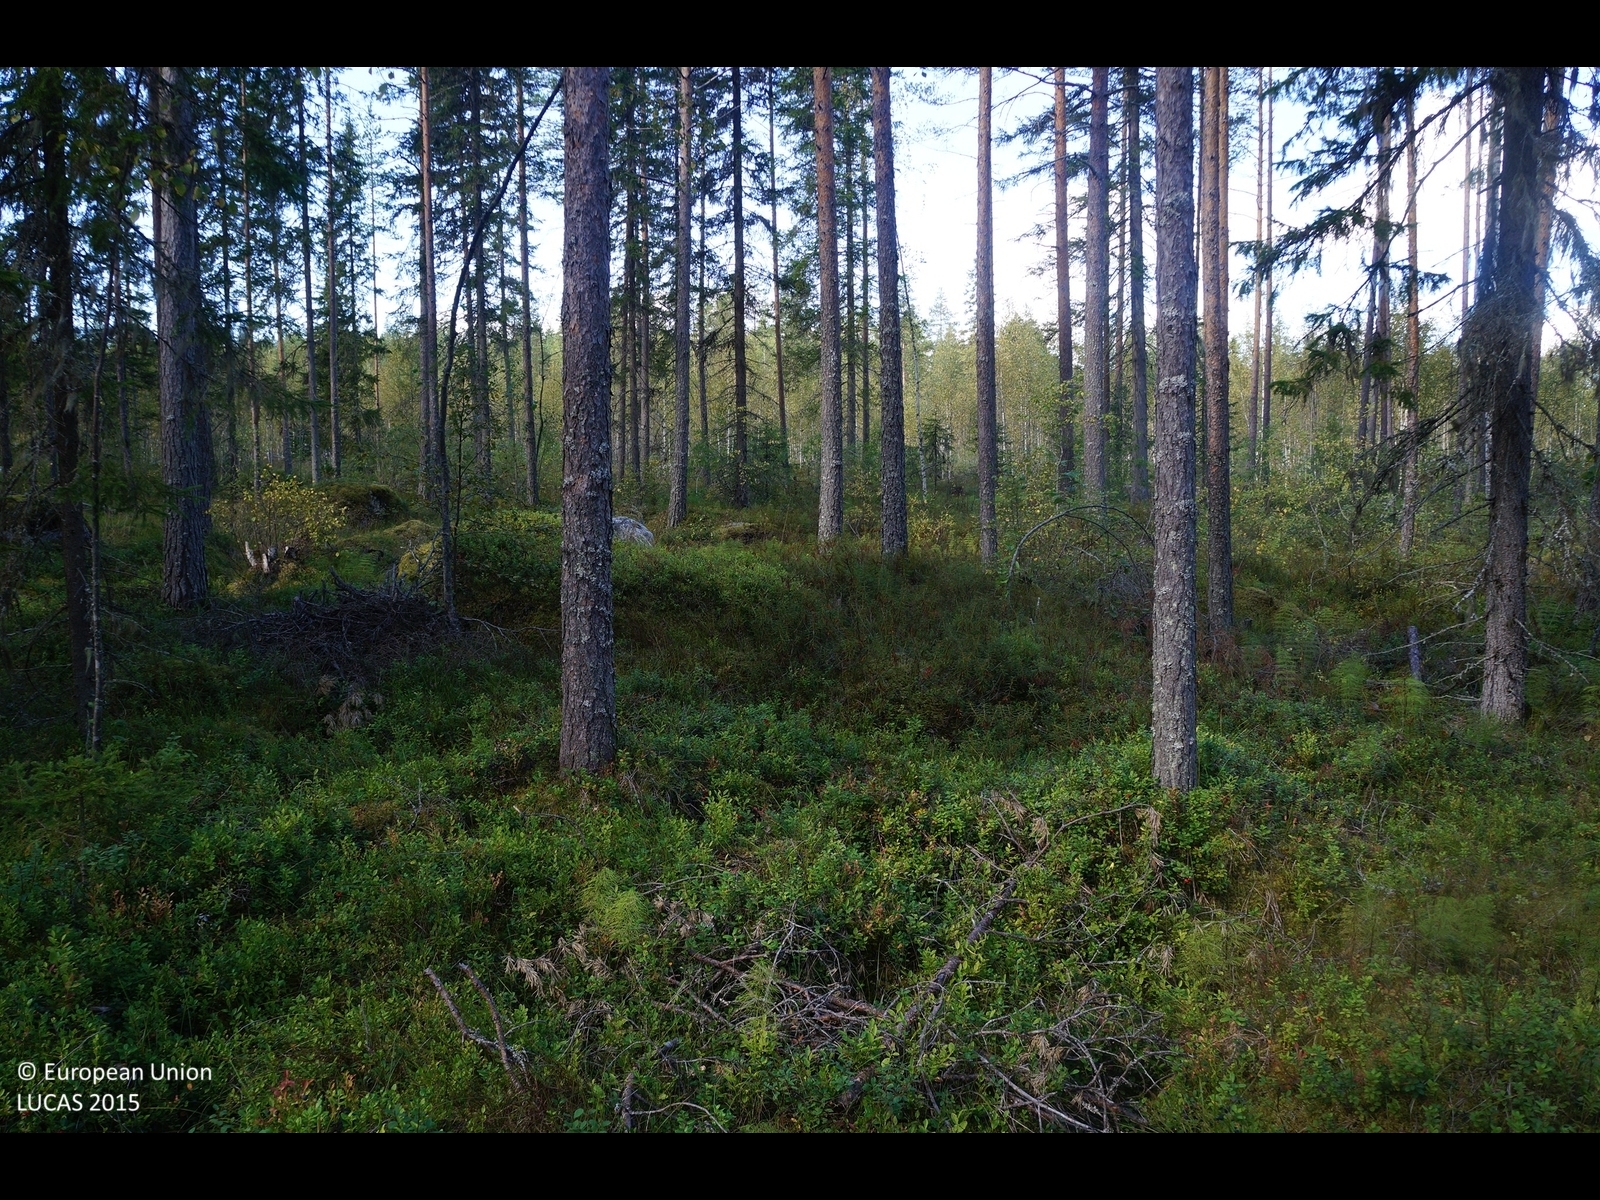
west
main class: Woodland
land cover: Pine dominated coniferous woodland
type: boreal forest
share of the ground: 25 - 50 %
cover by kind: coniferous forest trees 40 %, shrubs 40 %, herbaceous plants 5 %, lichens and mosses 5 %, consolidated bare surface 5 %, unconsolidated bare surface 5 %
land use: Forestry
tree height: > 5 m
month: September
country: FI
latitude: 63.9555
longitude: 24.4243
